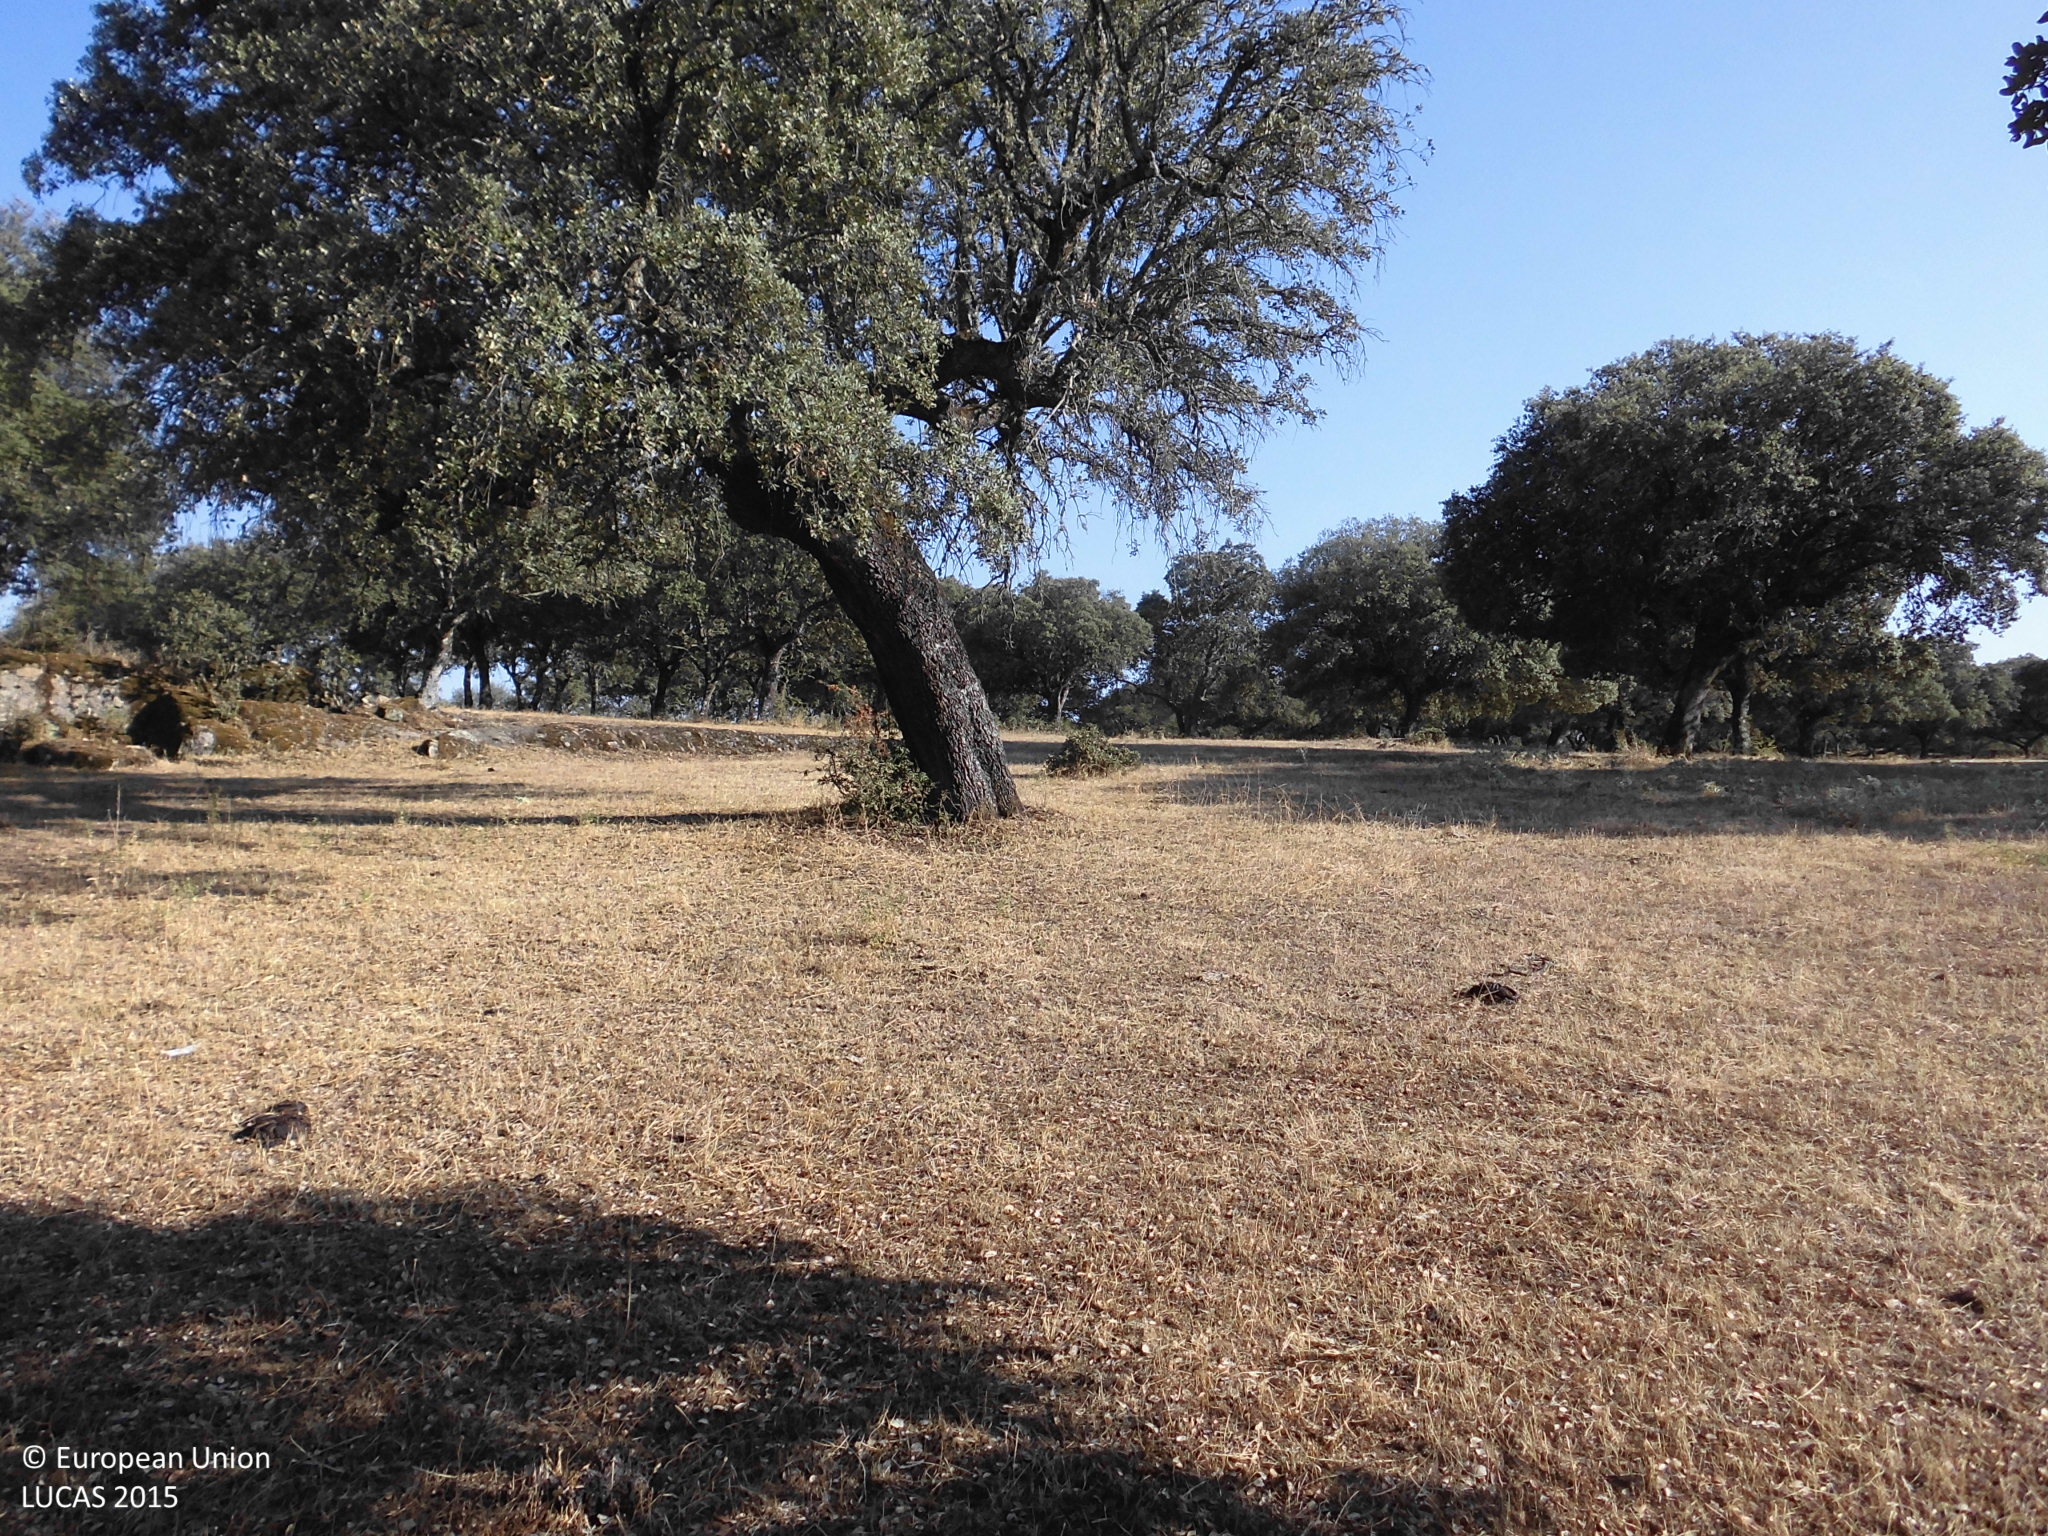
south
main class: Woodland
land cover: Broadleaved woodland
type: broadleaved evergreen forest
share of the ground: 25 - 50 %
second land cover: Grassland without tree/shrub cover
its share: > 75 %
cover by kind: herbaceous plants 70 %, broadleaved forest trees 30 %
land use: Forestry
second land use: Agriculture (excluding fallow land and kitchen gardens)
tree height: > 5 m
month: July
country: ES
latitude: 40.1532
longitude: -6.1460
